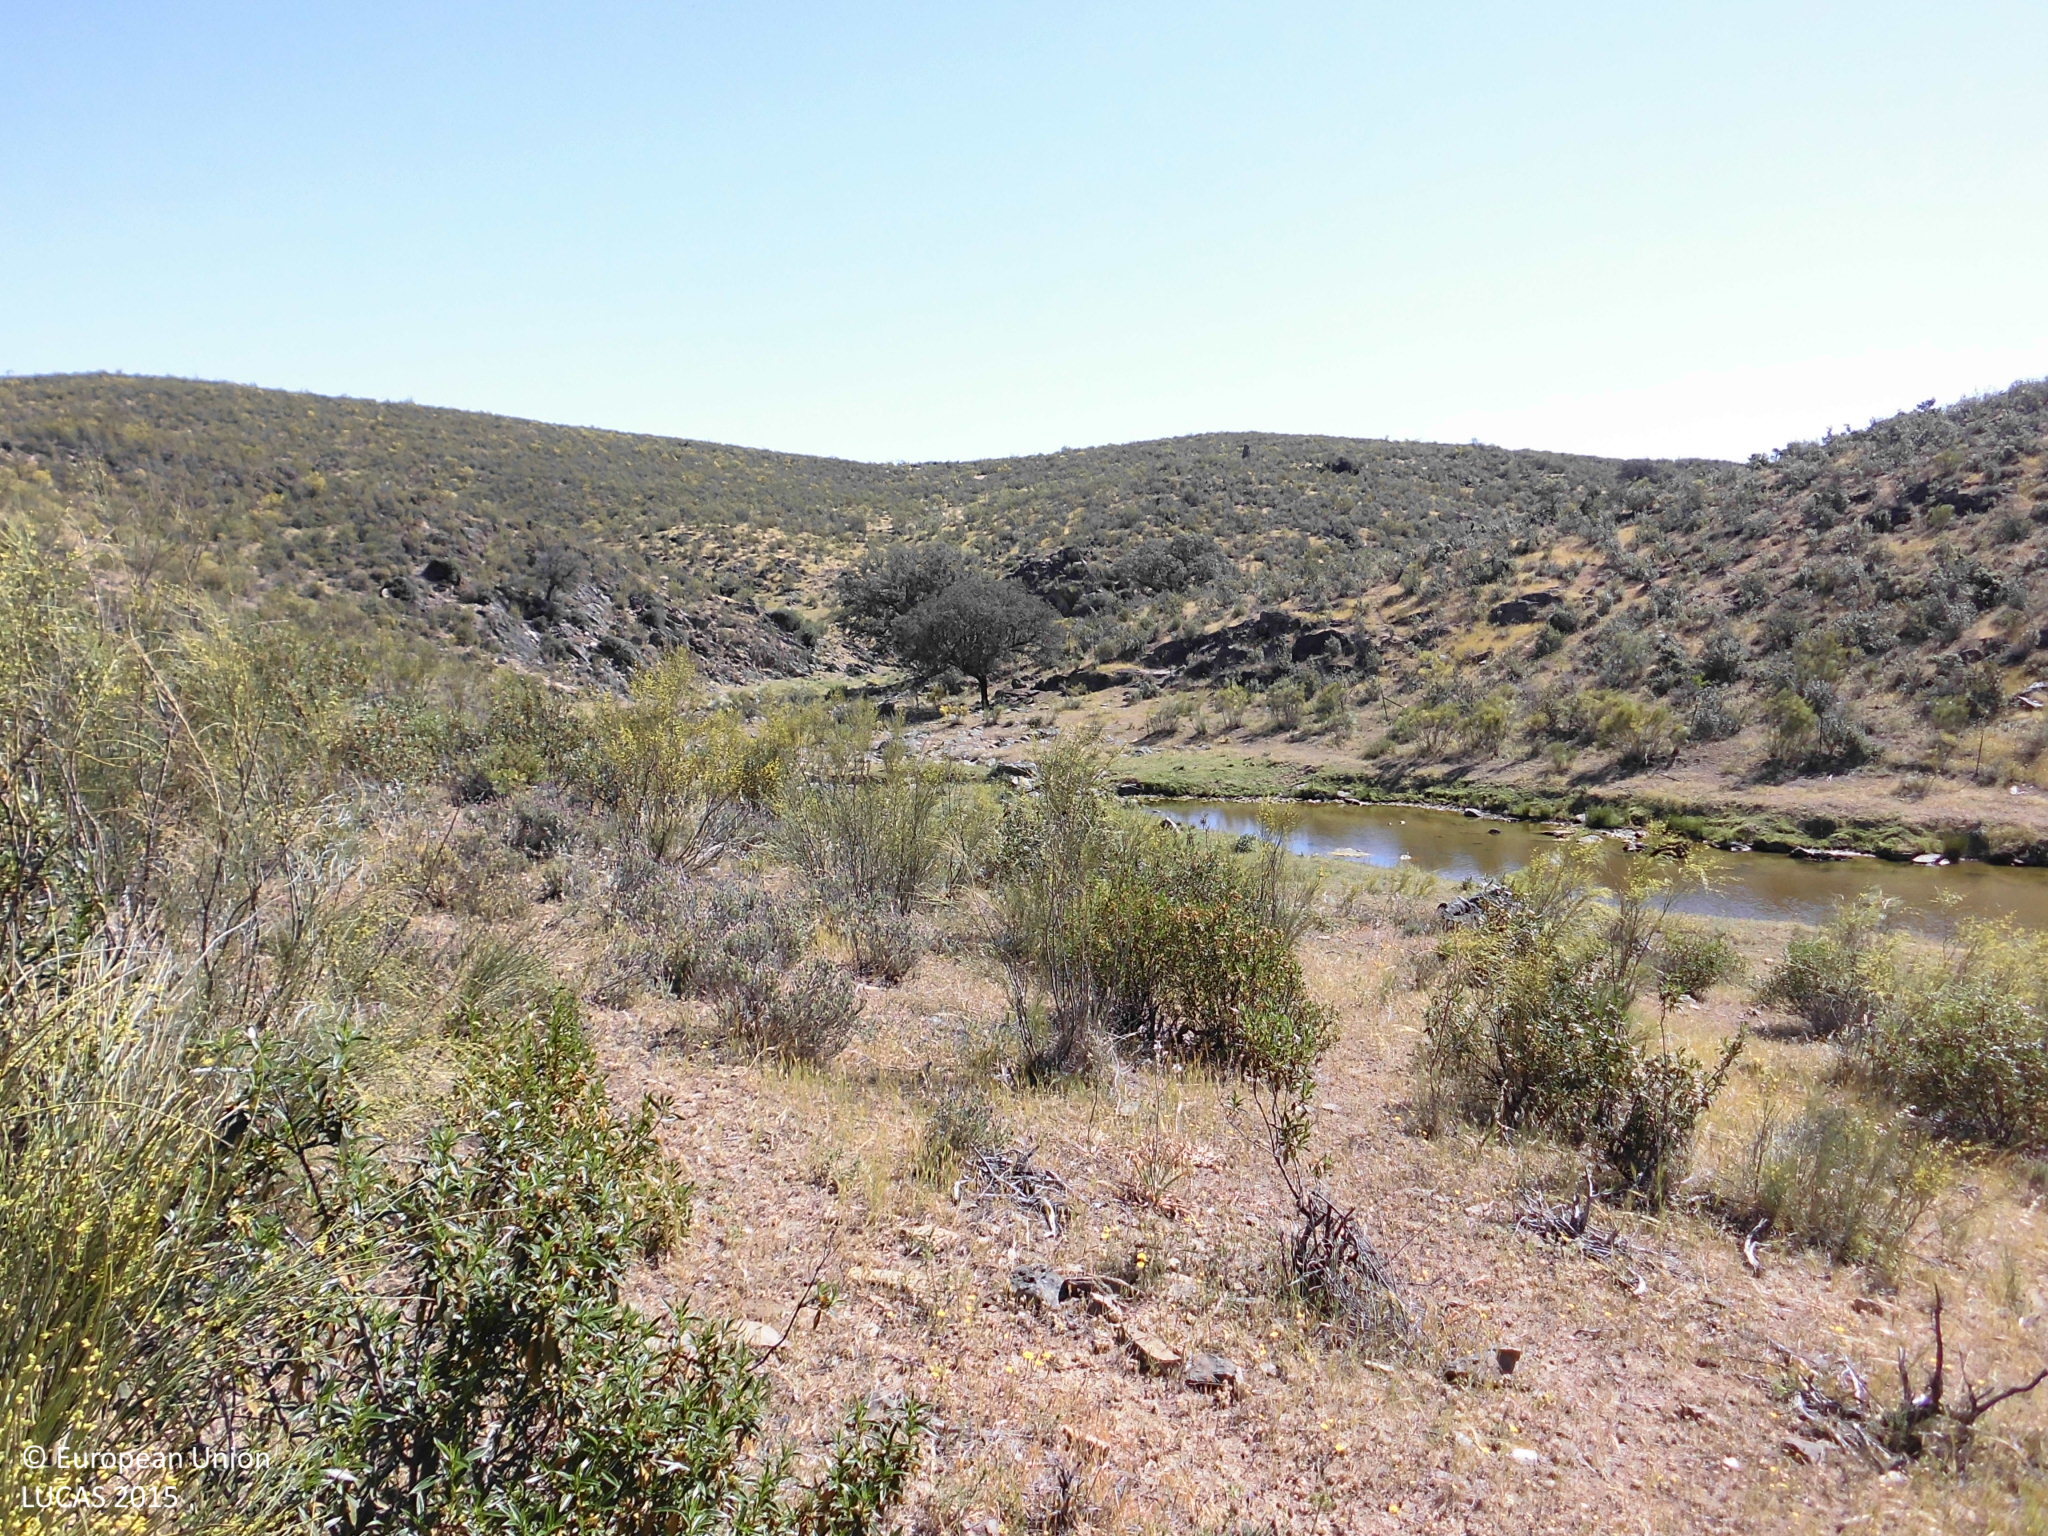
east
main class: Shrubland
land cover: Shrubland without tree cover
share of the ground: 50 - 75 %
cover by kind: shrubs 55 %, herbaceous plants 45 %
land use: Semi-natural and natural areas not in use
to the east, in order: Shrubland without tree cover; Rivers and streams; Fences; Grassland without tree/shrub cover; Shrubland without tree cover
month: May
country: ES
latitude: 39.4772
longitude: -6.9720
